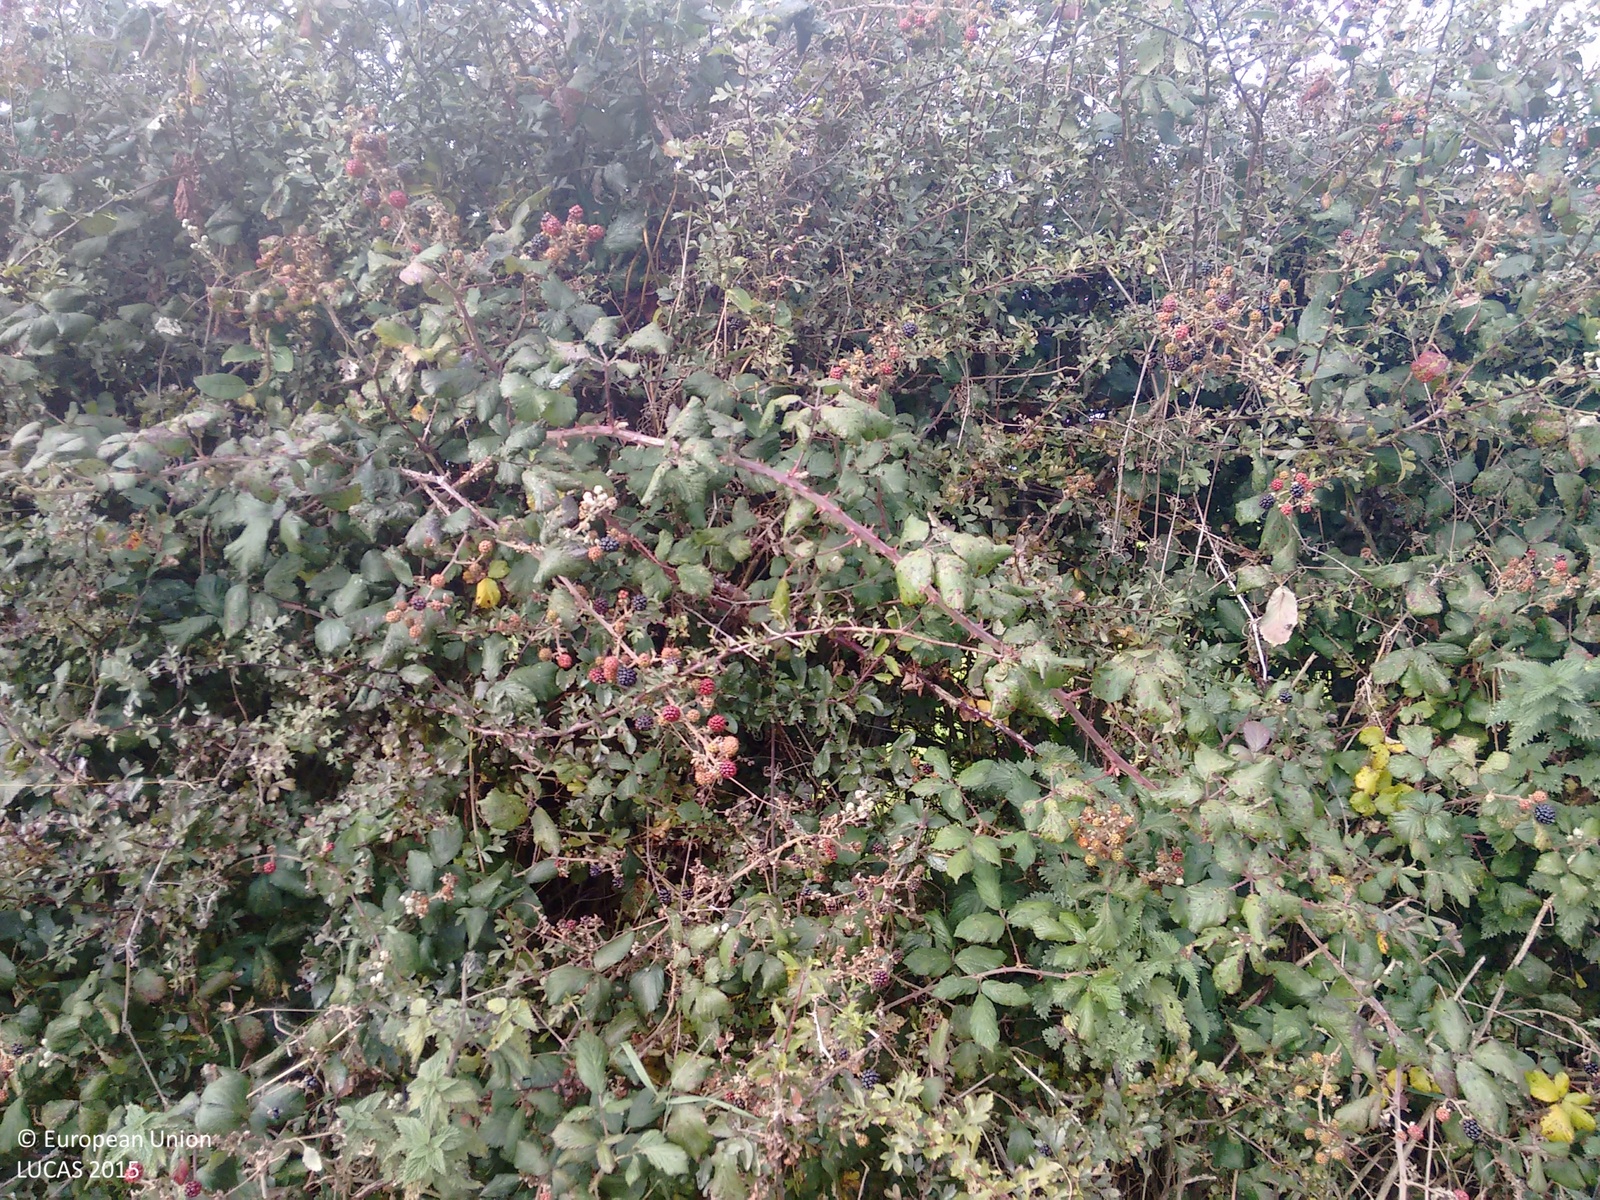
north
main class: Grassland
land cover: Grassland without tree/shrub cover
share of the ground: > 75 %
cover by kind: herbaceous plants 95 %, shrubs 5 %
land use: Agriculture (excluding fallow land and kitchen gardens)
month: October
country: IE
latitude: 52.8776
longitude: -7.5601
